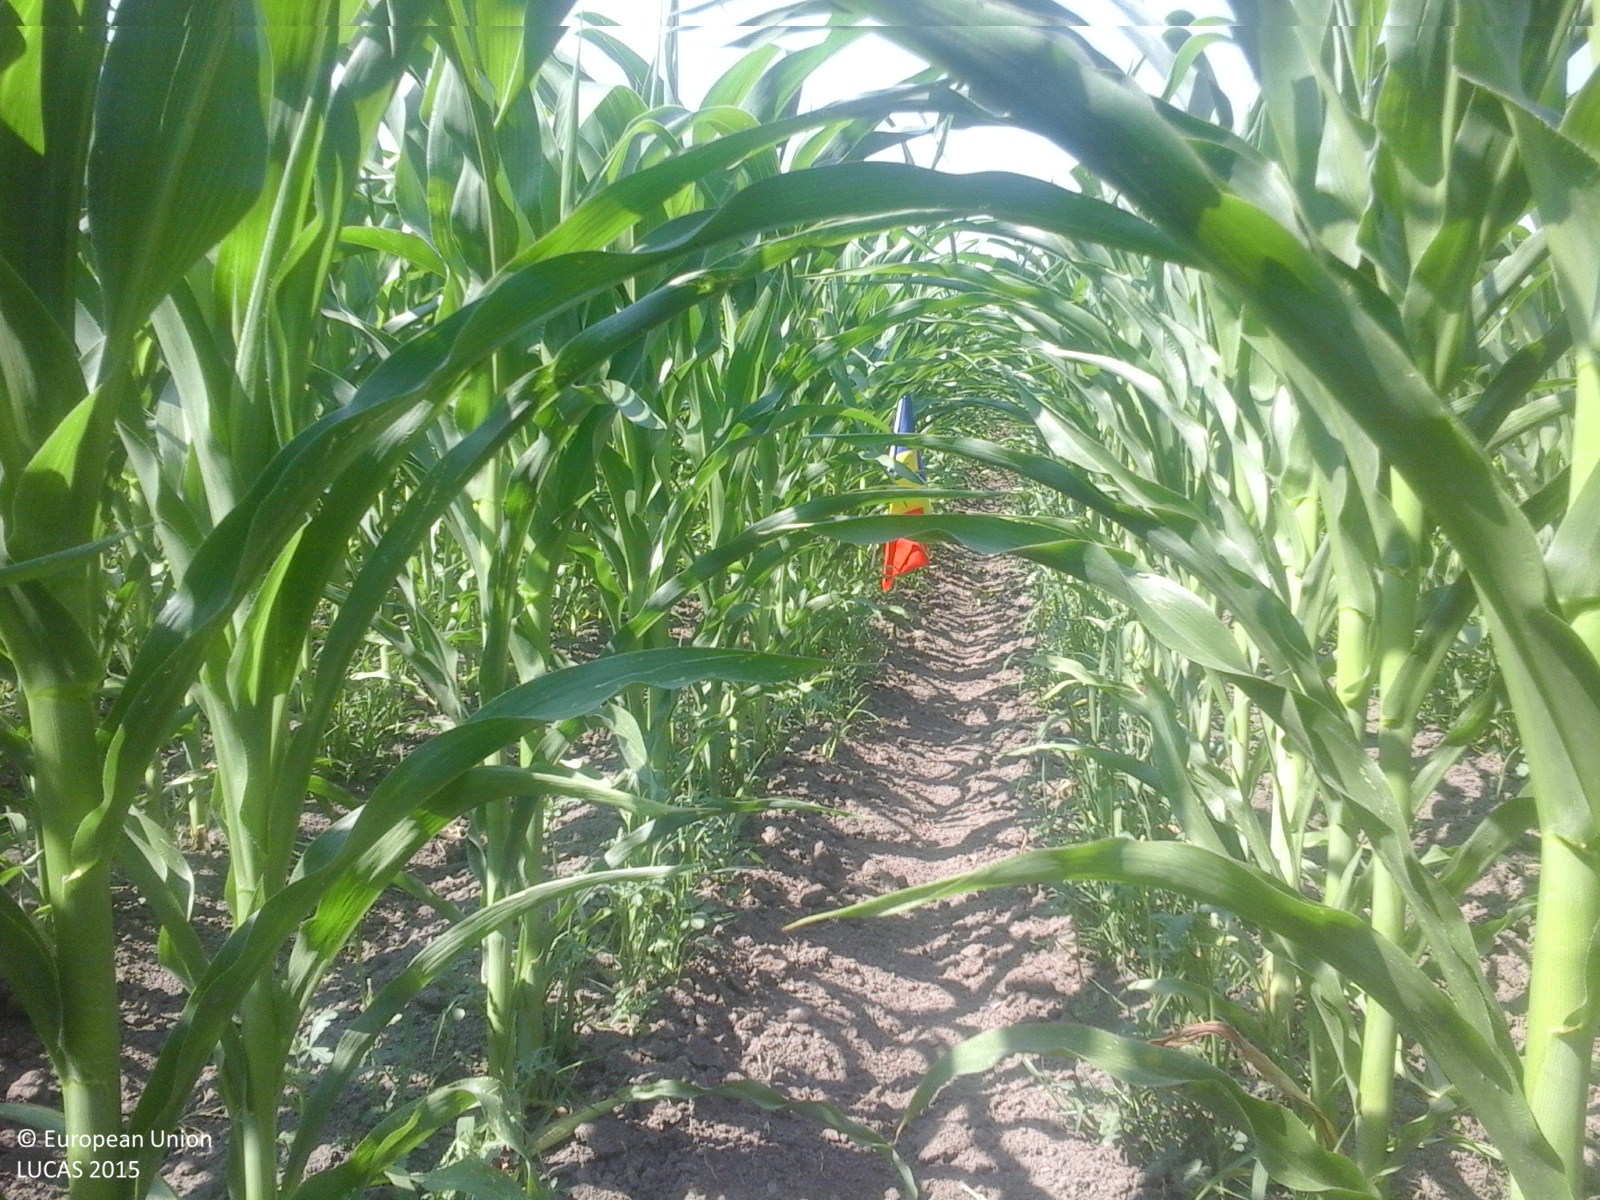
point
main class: Cropland
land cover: Maize
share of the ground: > 75 %
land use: Agriculture (excluding fallow land and kitchen gardens)
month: July
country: RO
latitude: 44.5787
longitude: 24.8257
